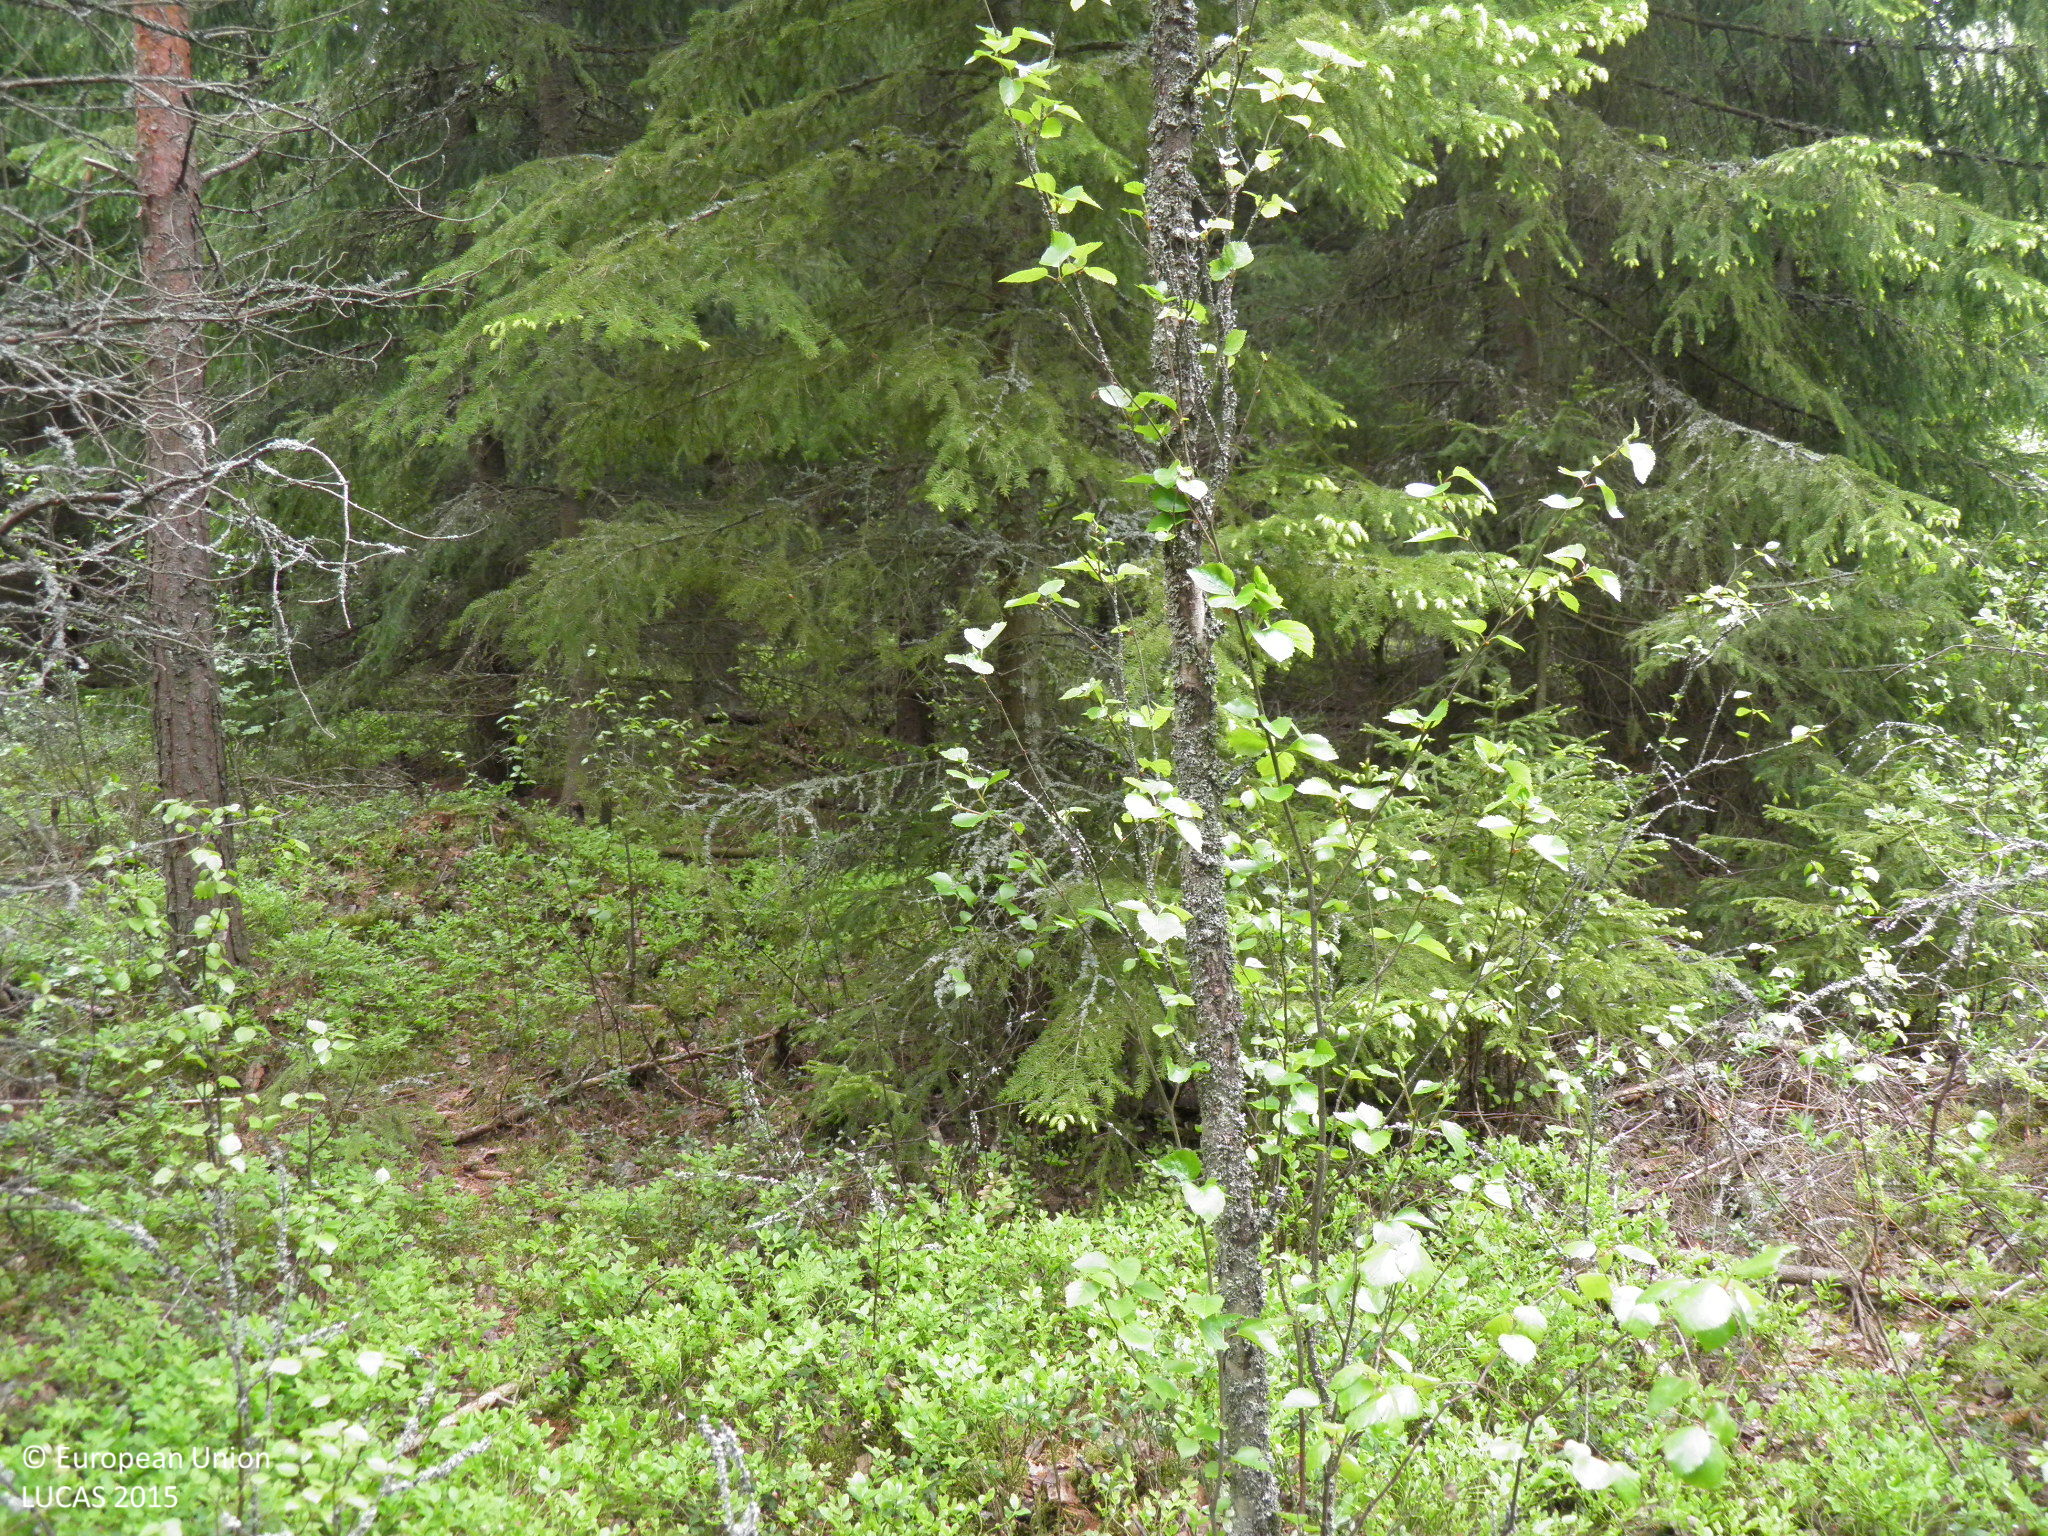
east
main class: Woodland
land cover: Spruce dominated coniferous woodland
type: boreal forest
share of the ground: > 75 %
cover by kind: coniferous forest trees 75 %, broadleaved forest trees 20 %, shrubs 5 %
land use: Forestry
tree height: > 5 m
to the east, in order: Spruce dominated coniferous woodland; Pine dominated coniferous woodland
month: June
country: FI
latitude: 60.5316
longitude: 22.3318
